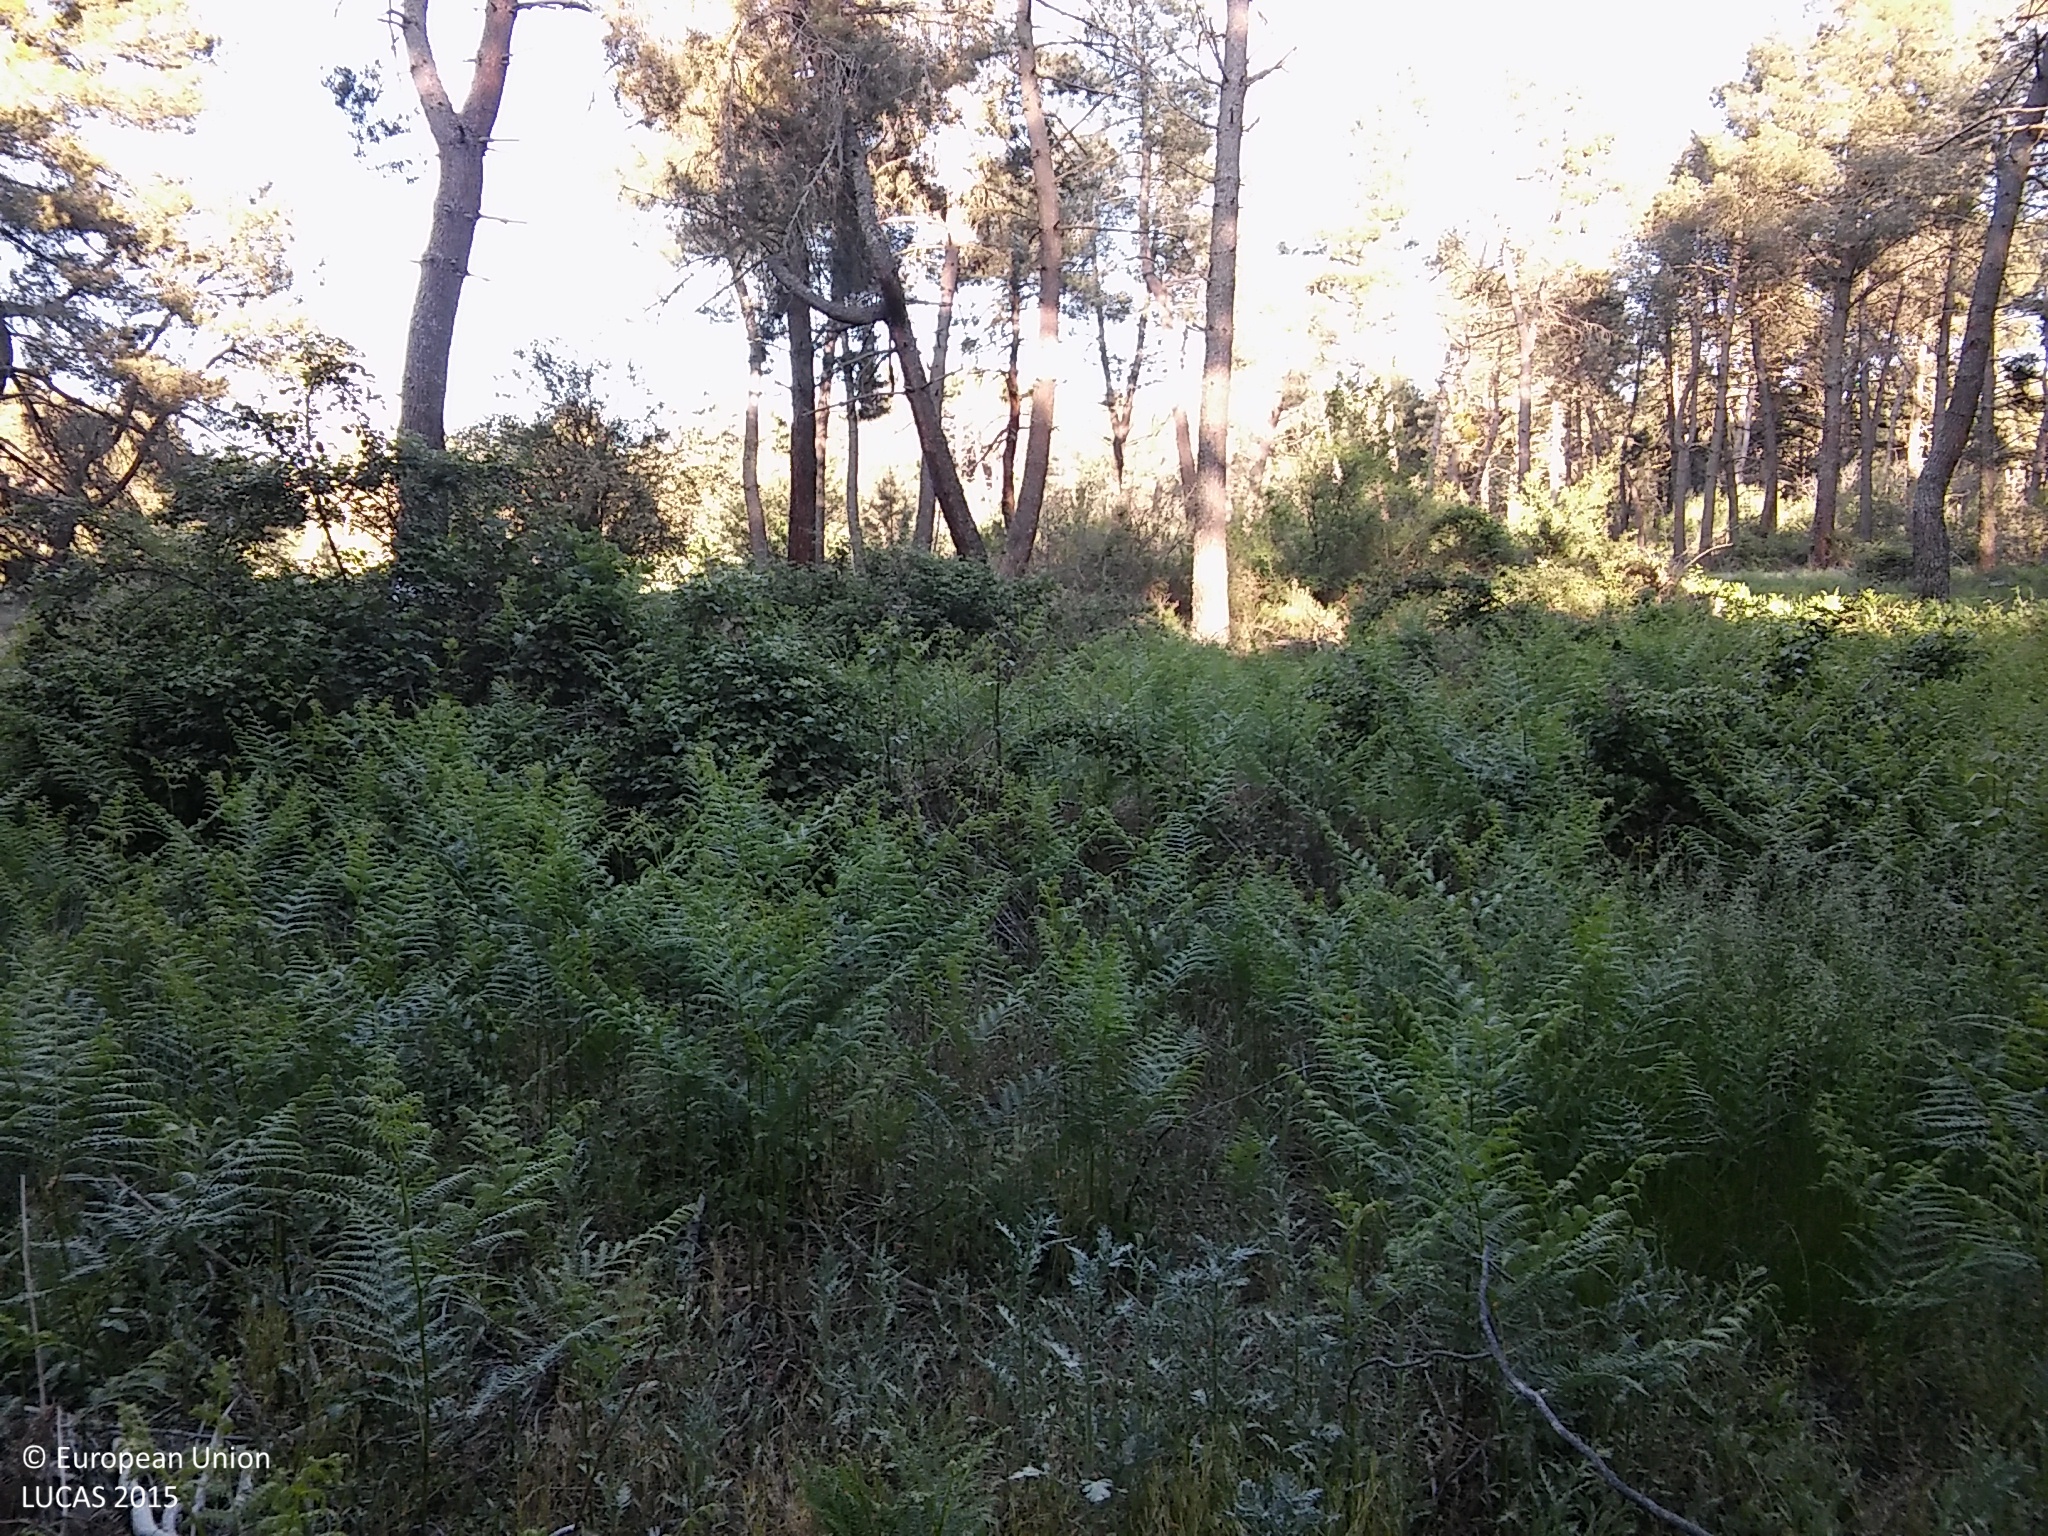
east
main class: Woodland
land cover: Pine dominated mixed woodland
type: coniferous forest of the mediterranean region
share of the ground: 50 - 75 %
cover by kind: coniferous forest trees 55 %, broadleaved forest trees 20 %, shrubs 20 %, herbaceous plants 5 %
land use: Forestry
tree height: > 5 m
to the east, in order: Pine dominated mixed woodland; Shrubland with sparse tree cover; Other structural elements; Shrubland without tree cover; Grassland without tree/shrub cover; Shrubland without tree cover; Grassland without tree/shrub cover; Pine dominated coniferous woodland
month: May
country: ES
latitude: 41.3466
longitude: -4.0007
